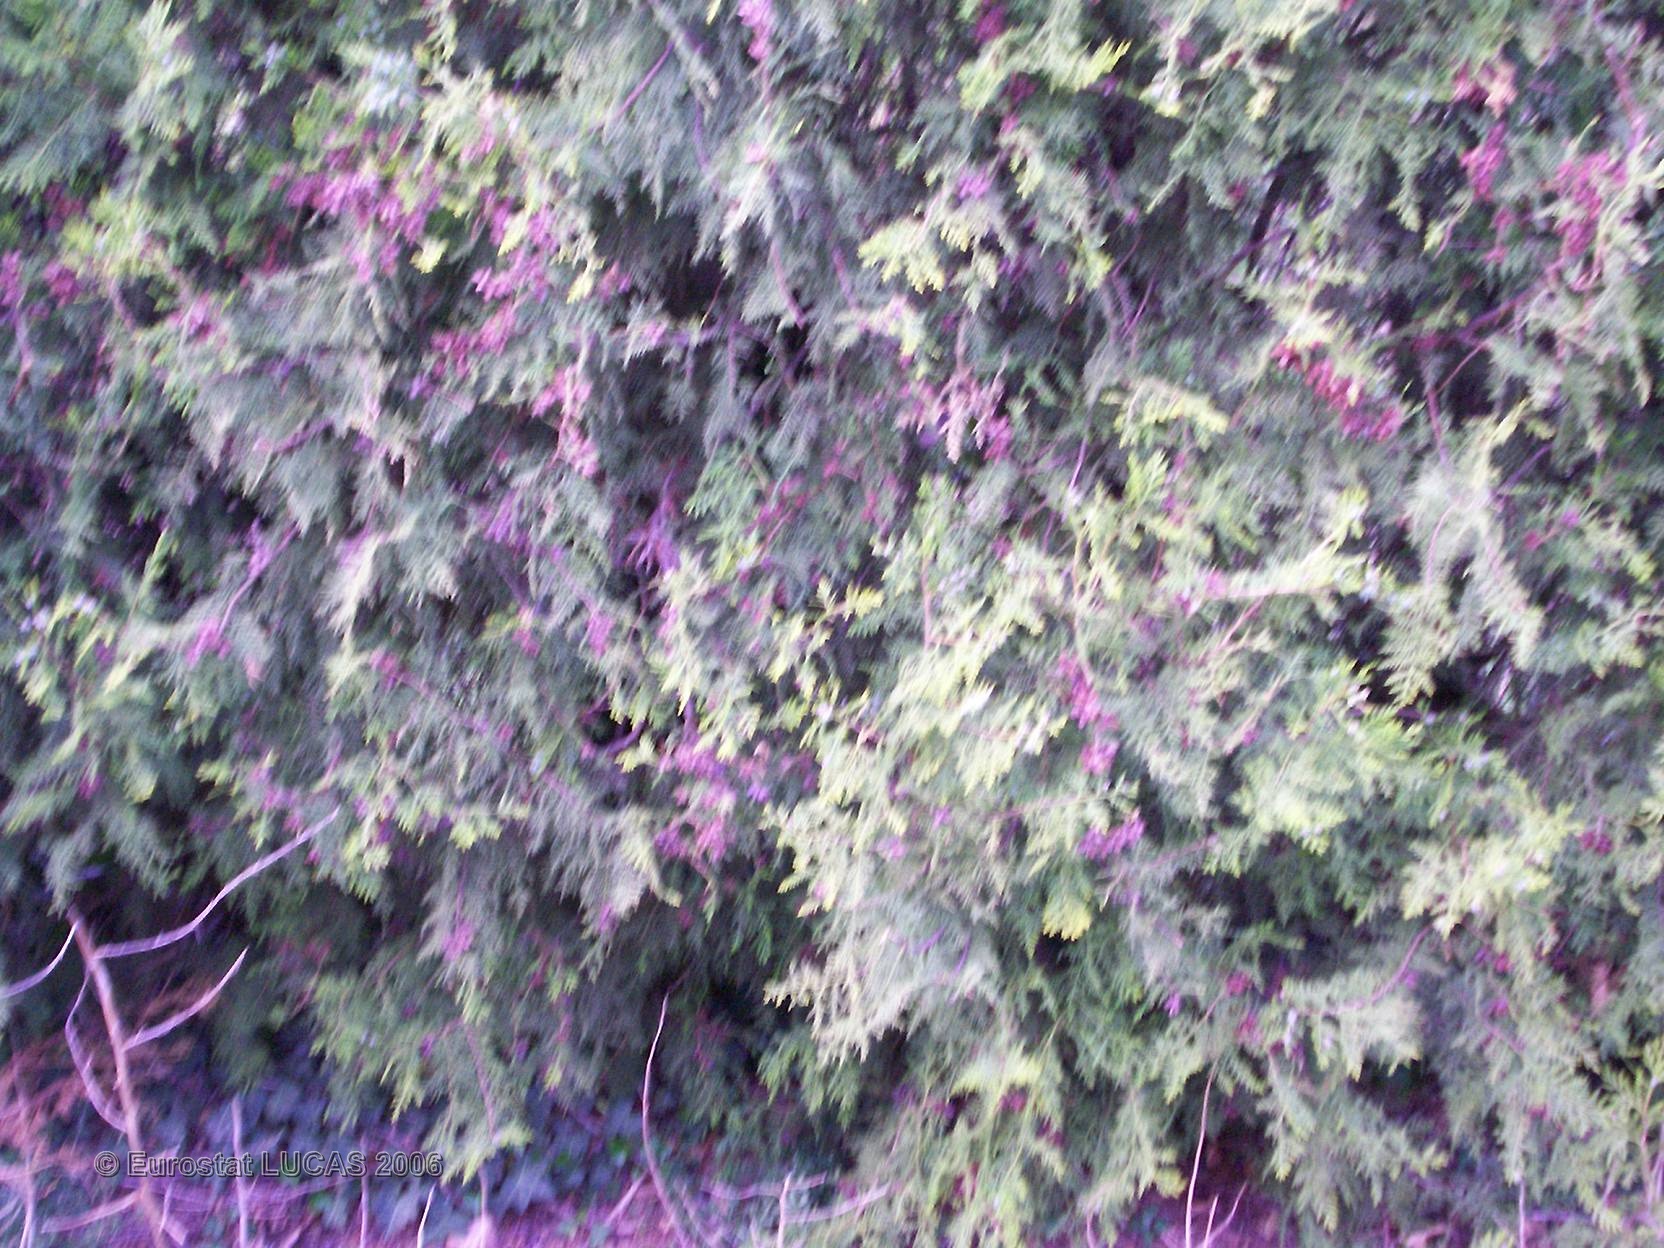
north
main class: Cropland
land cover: Cherry fruit
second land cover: Grassland with sparse tree/shrub cover
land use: Agriculture (excluding fallow land and kitchen gardens)
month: April
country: FR
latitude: 43.6500
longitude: 4.9634
